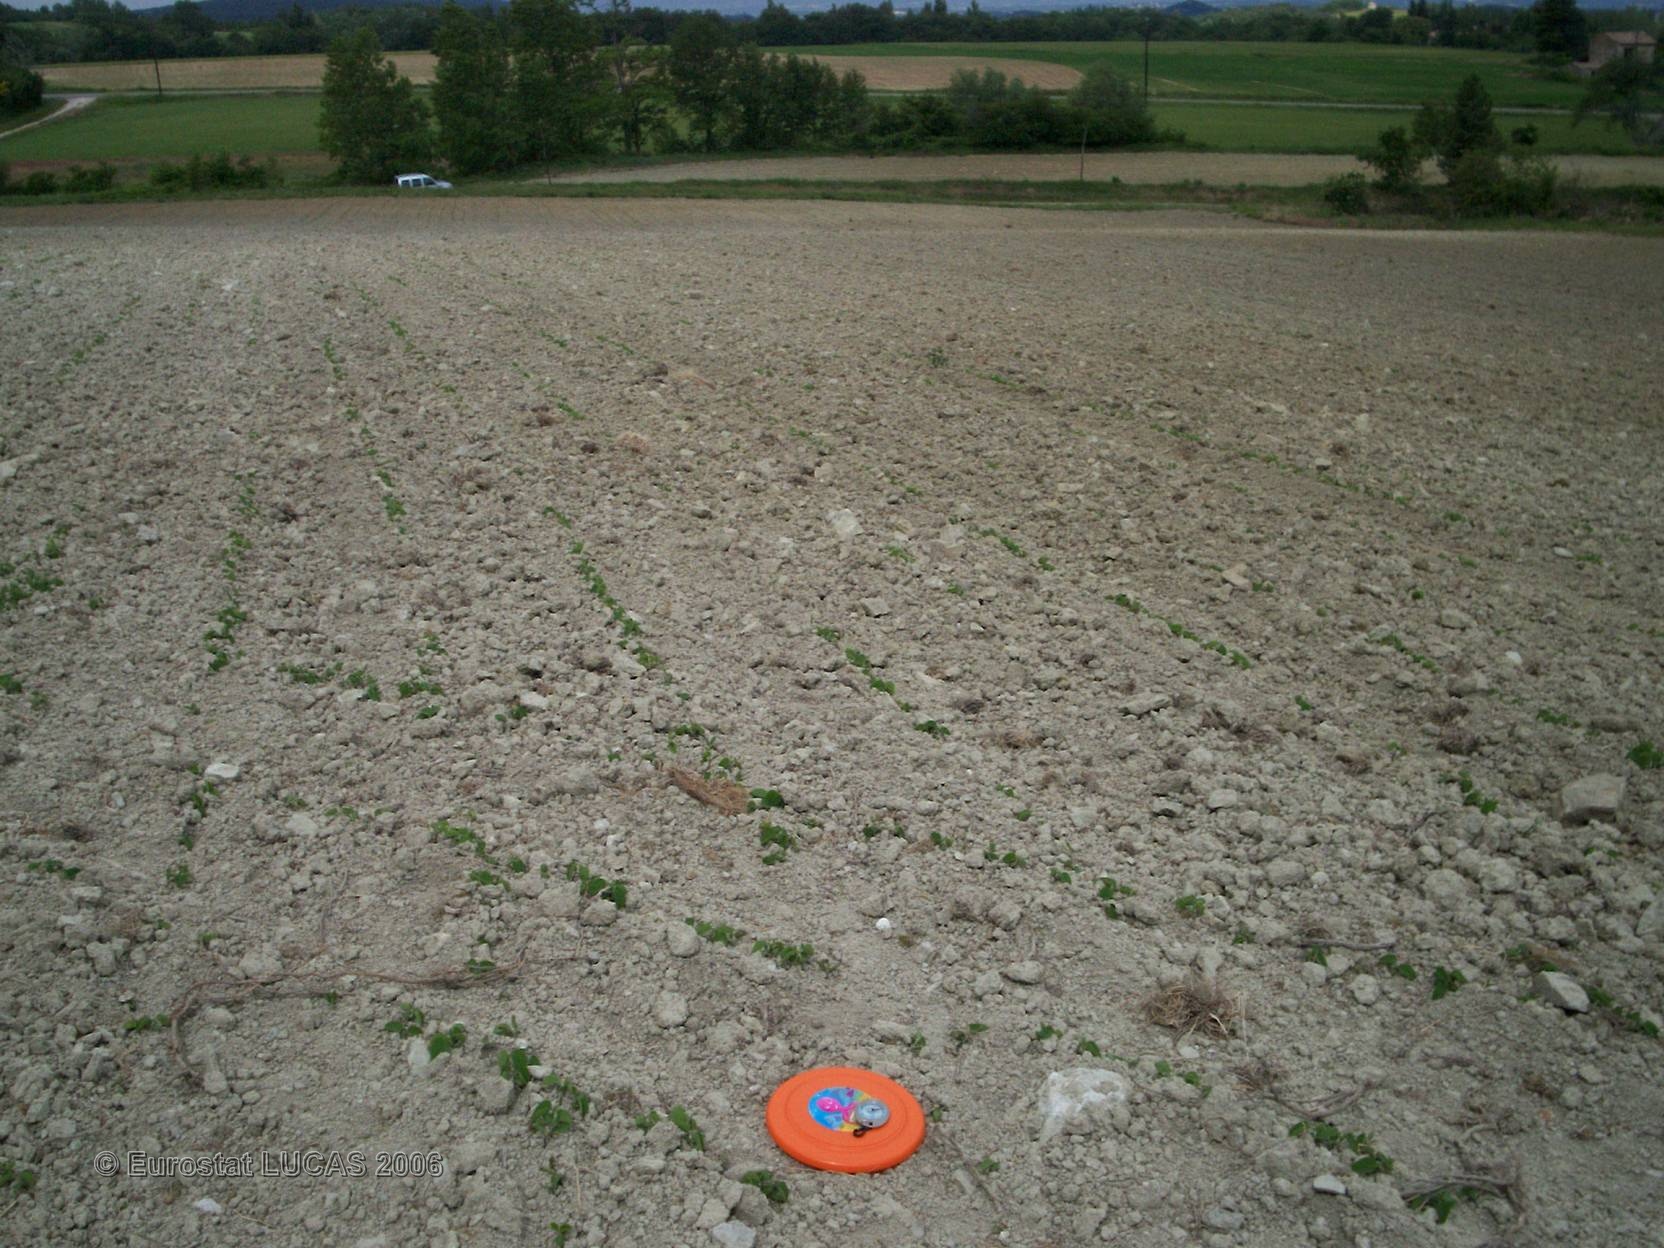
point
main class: Cropland
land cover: Soya
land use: Agriculture (excluding fallow land and kitchen gardens)
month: June
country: FR
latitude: 44.5341
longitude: 4.9354
